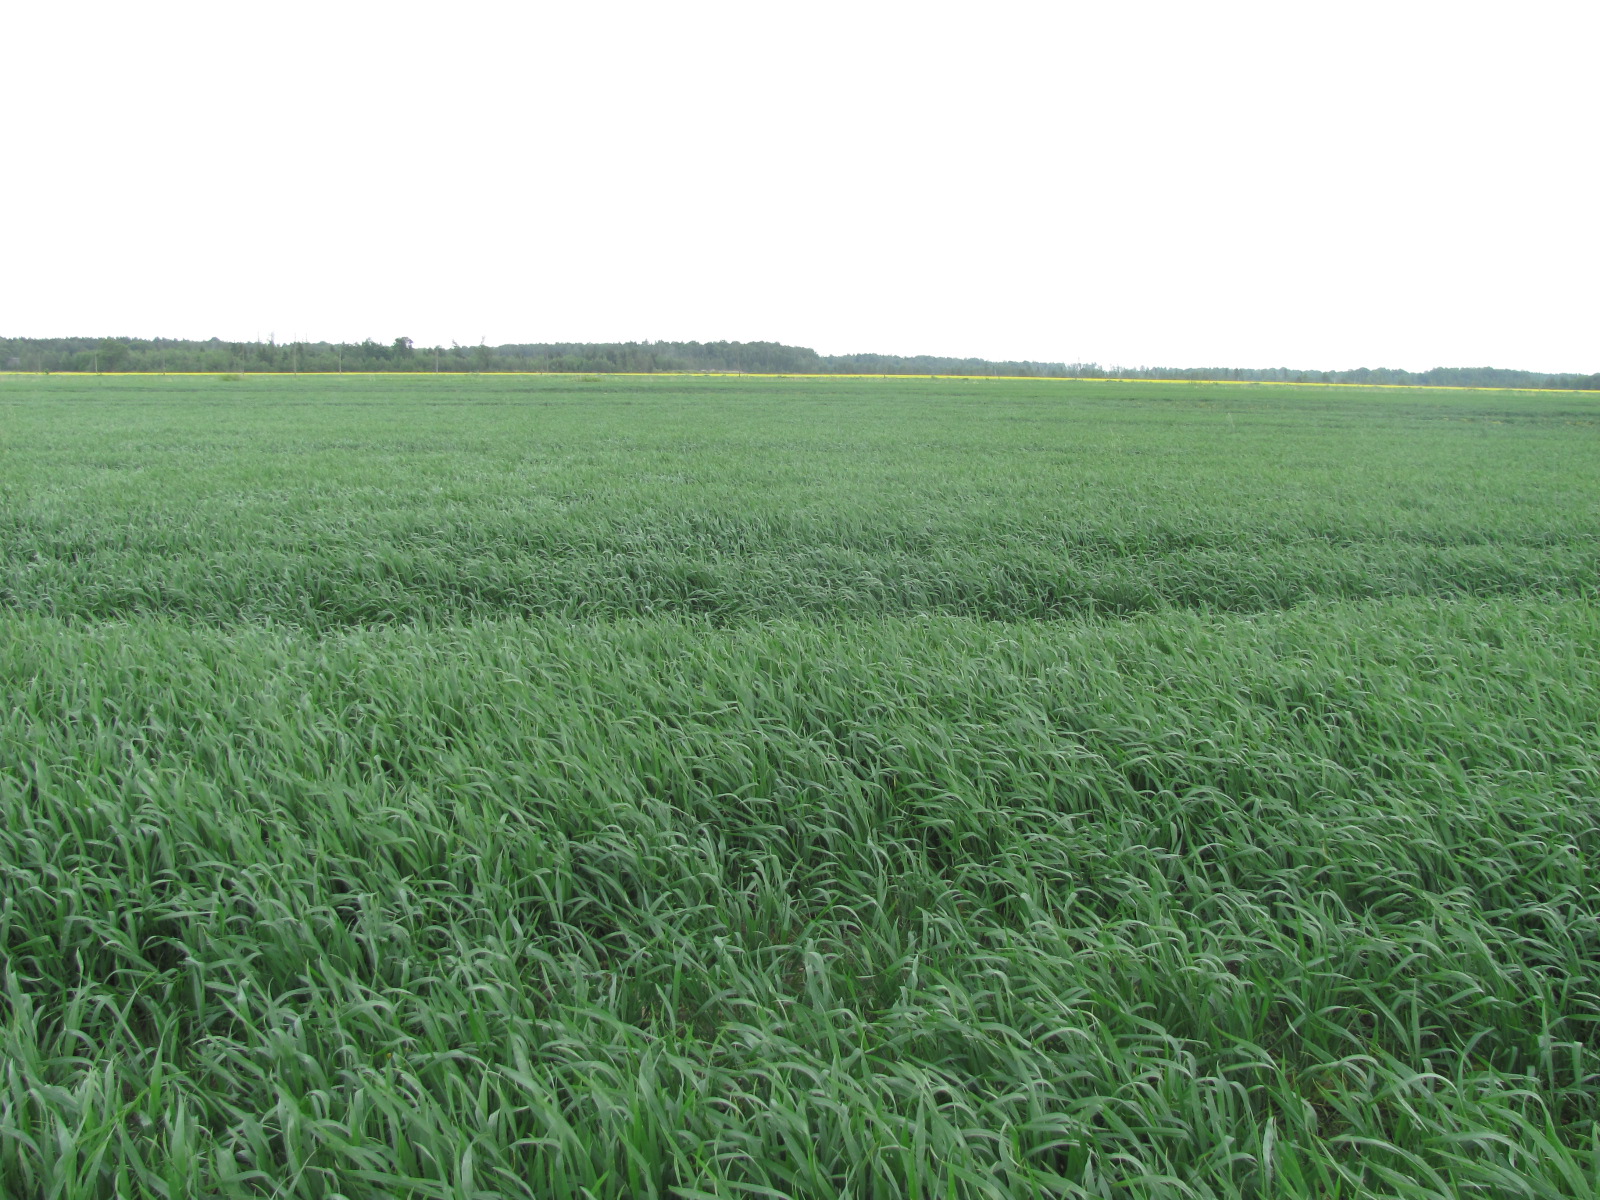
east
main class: Cropland
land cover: Common wheat
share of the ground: > 75 %
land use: Agriculture (excluding fallow land and kitchen gardens)
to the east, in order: Common wheat; Other bare soil; Common wheat; Grass margins; Abandoned hedges; Ditches and canals; Abandoned hedges; Grass margins; Common wheat
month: June
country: LV
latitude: 56.7849
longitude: 24.0136
